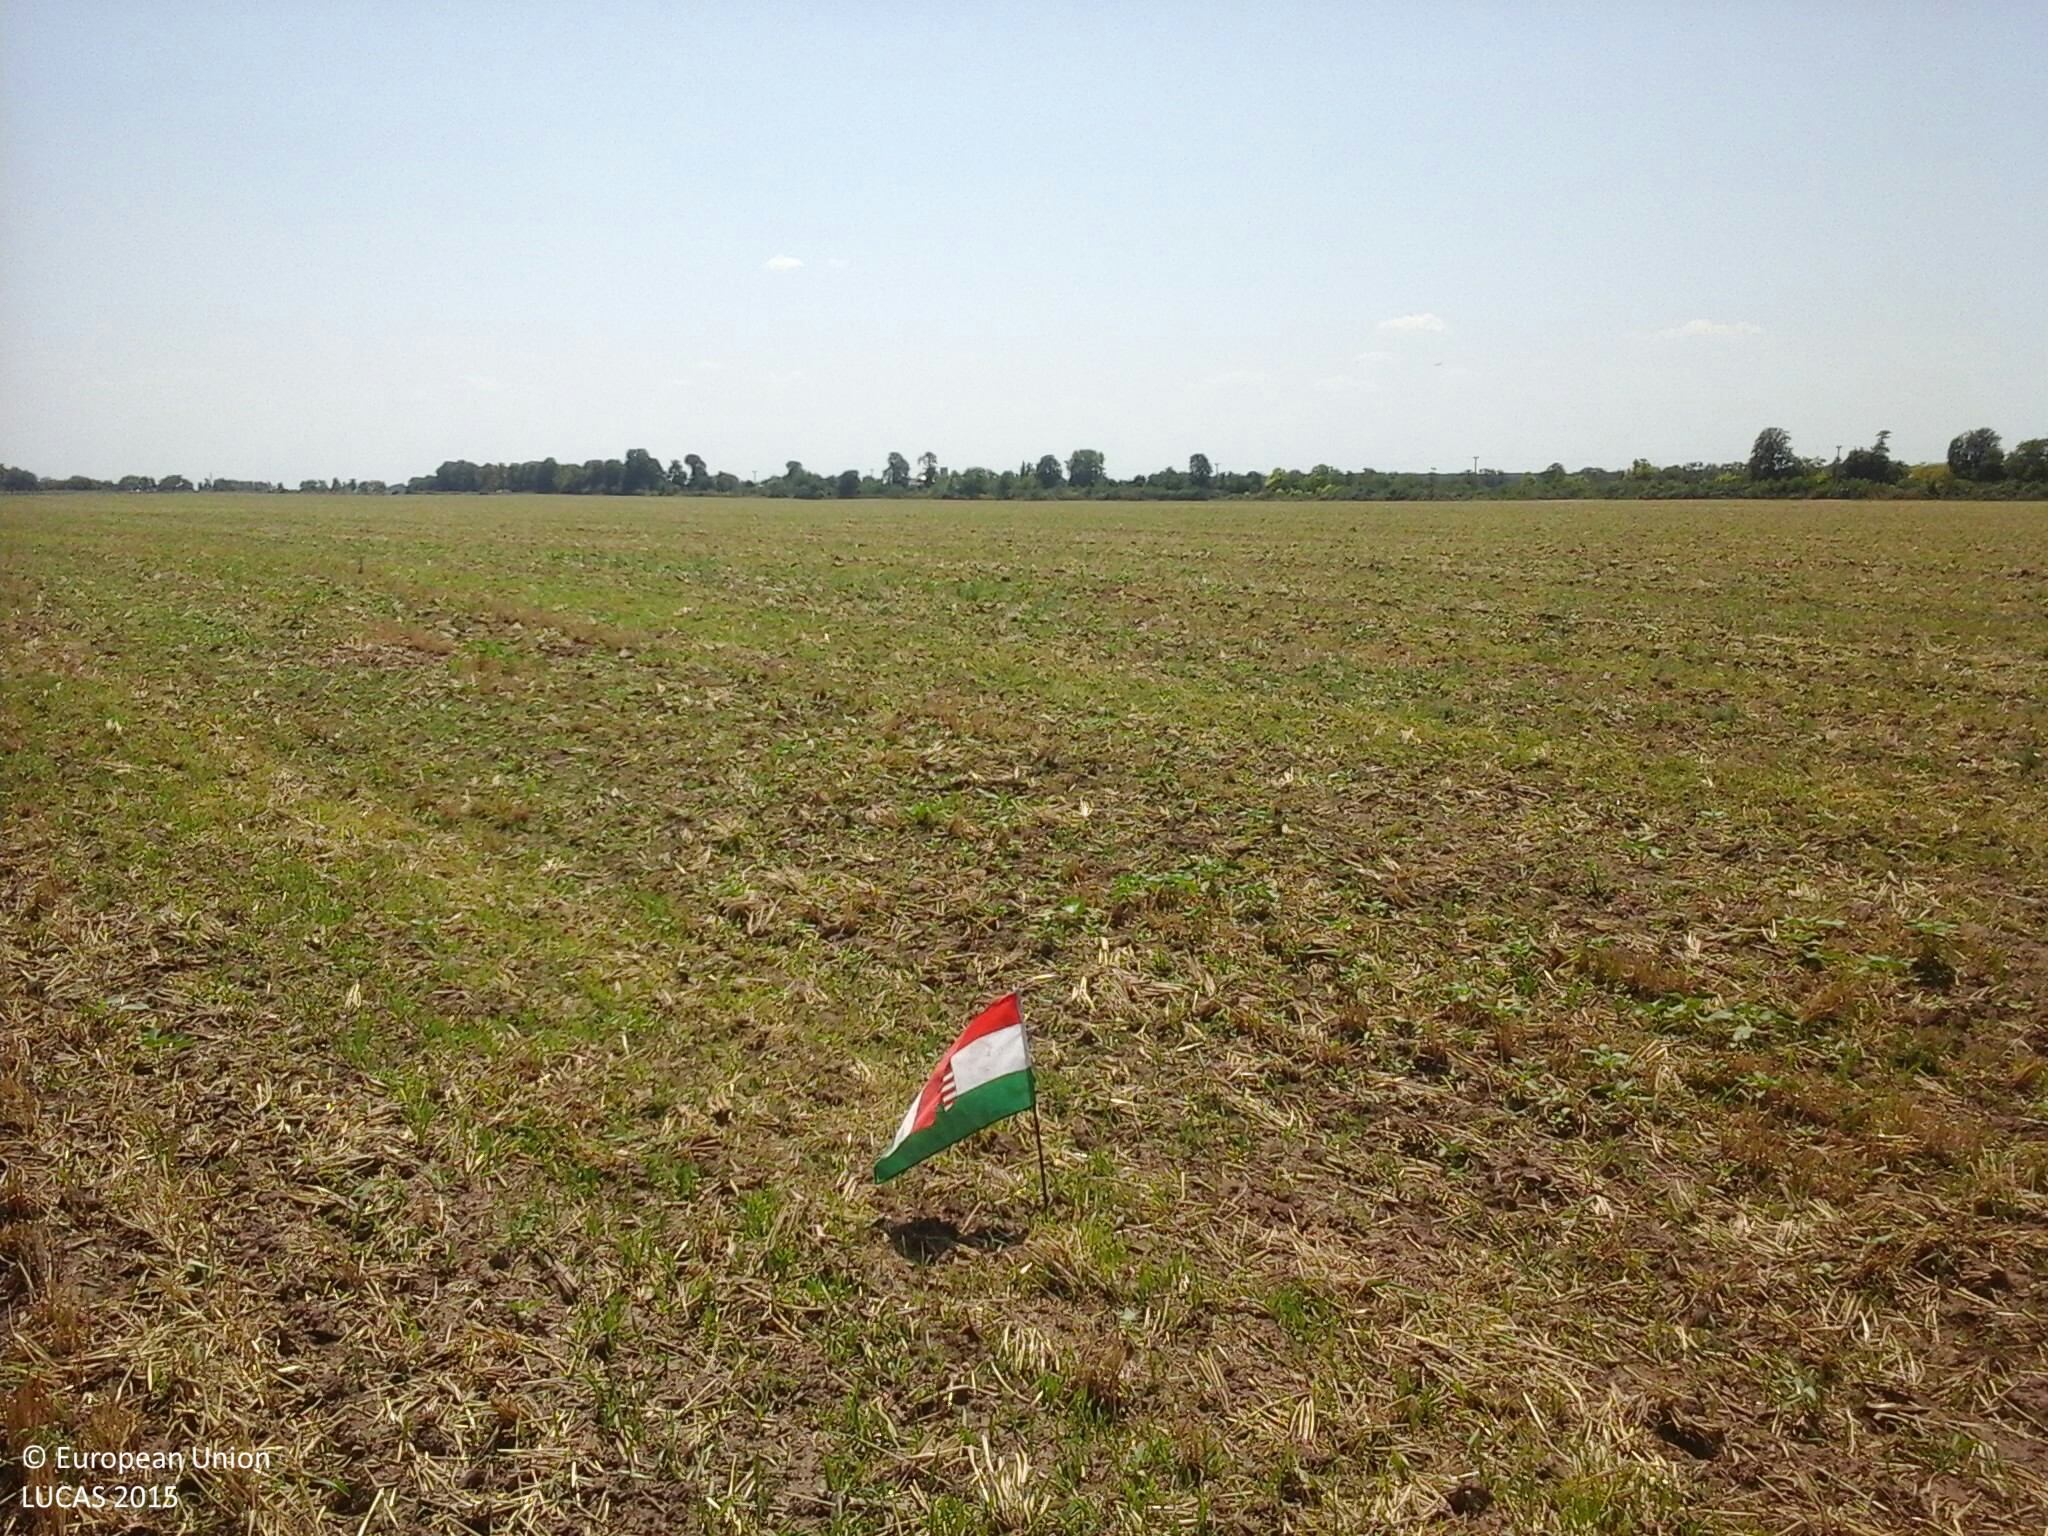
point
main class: Cropland
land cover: Common wheat
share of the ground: < 10 %
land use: Agriculture (excluding fallow land and kitchen gardens)
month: July
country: HU
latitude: 47.0823
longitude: 18.2429
